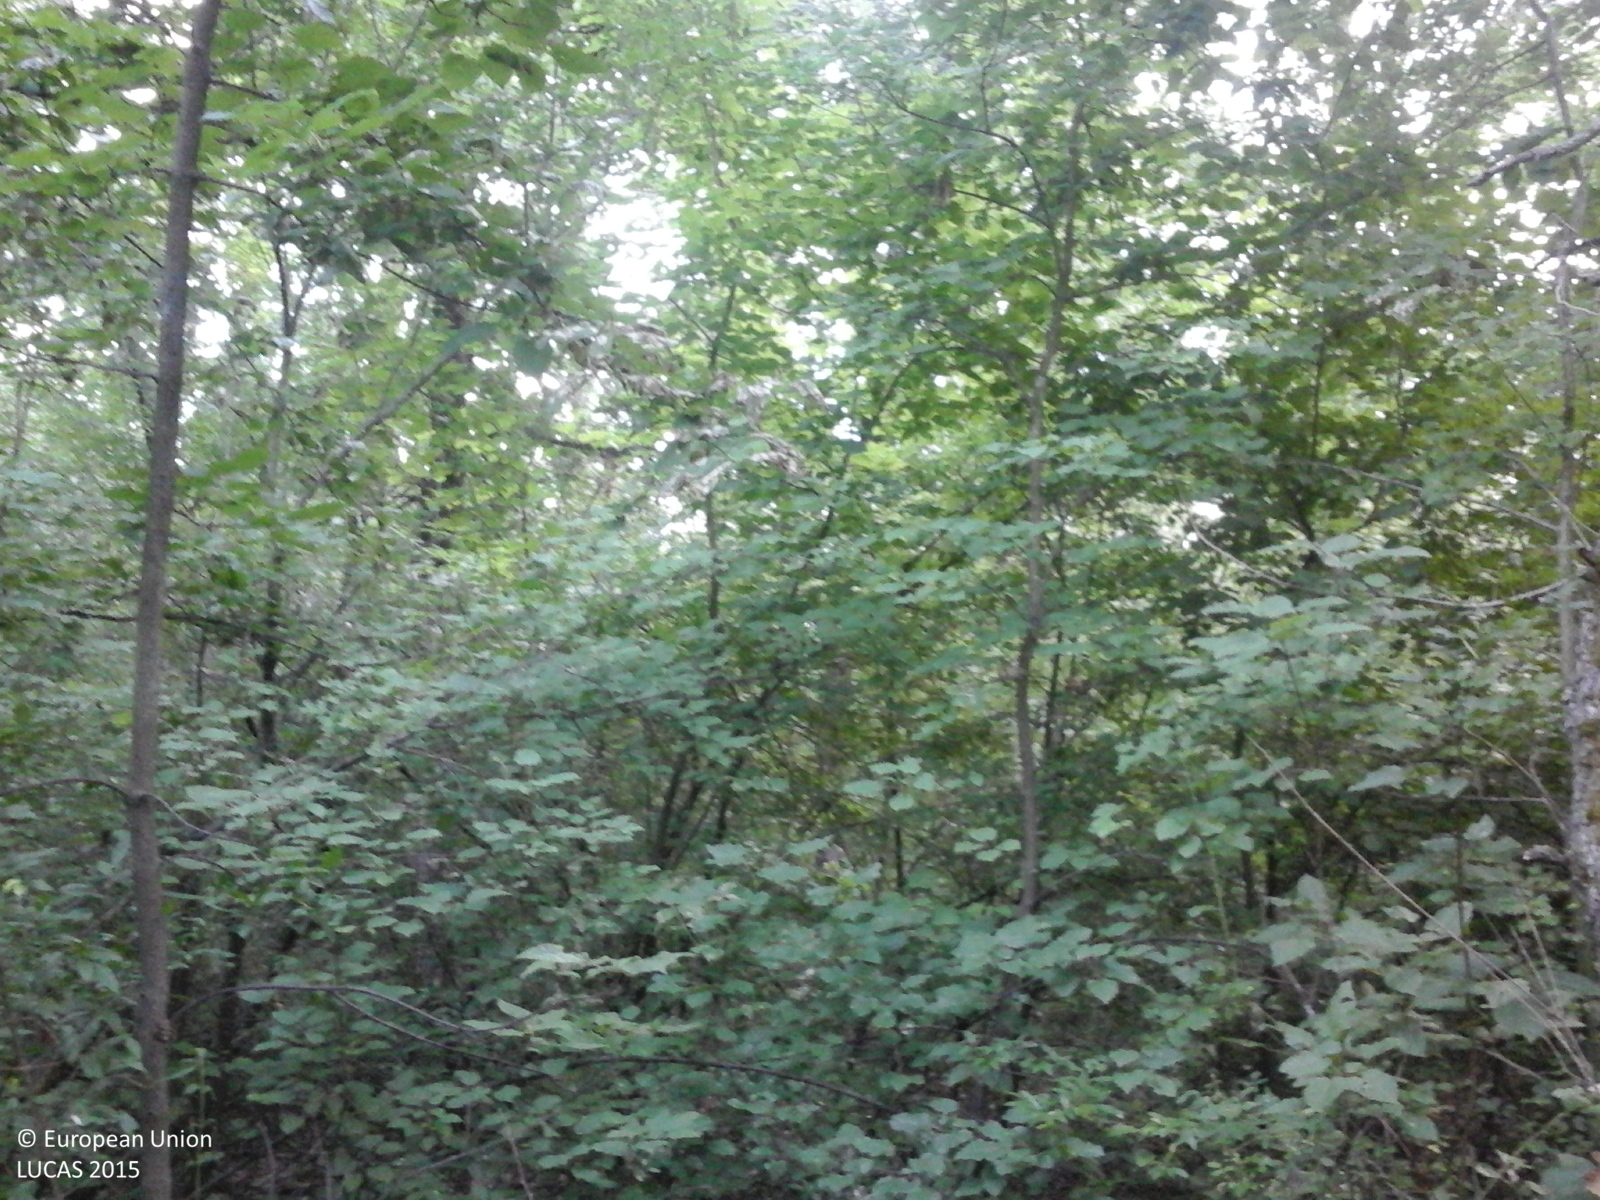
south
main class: Woodland
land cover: Broadleaved woodland
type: beech forest
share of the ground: > 75 %
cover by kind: broadleaved forest trees 100 %
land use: Forestry
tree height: > 5 m
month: July
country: RO
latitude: 44.4064
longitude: 25.4981
